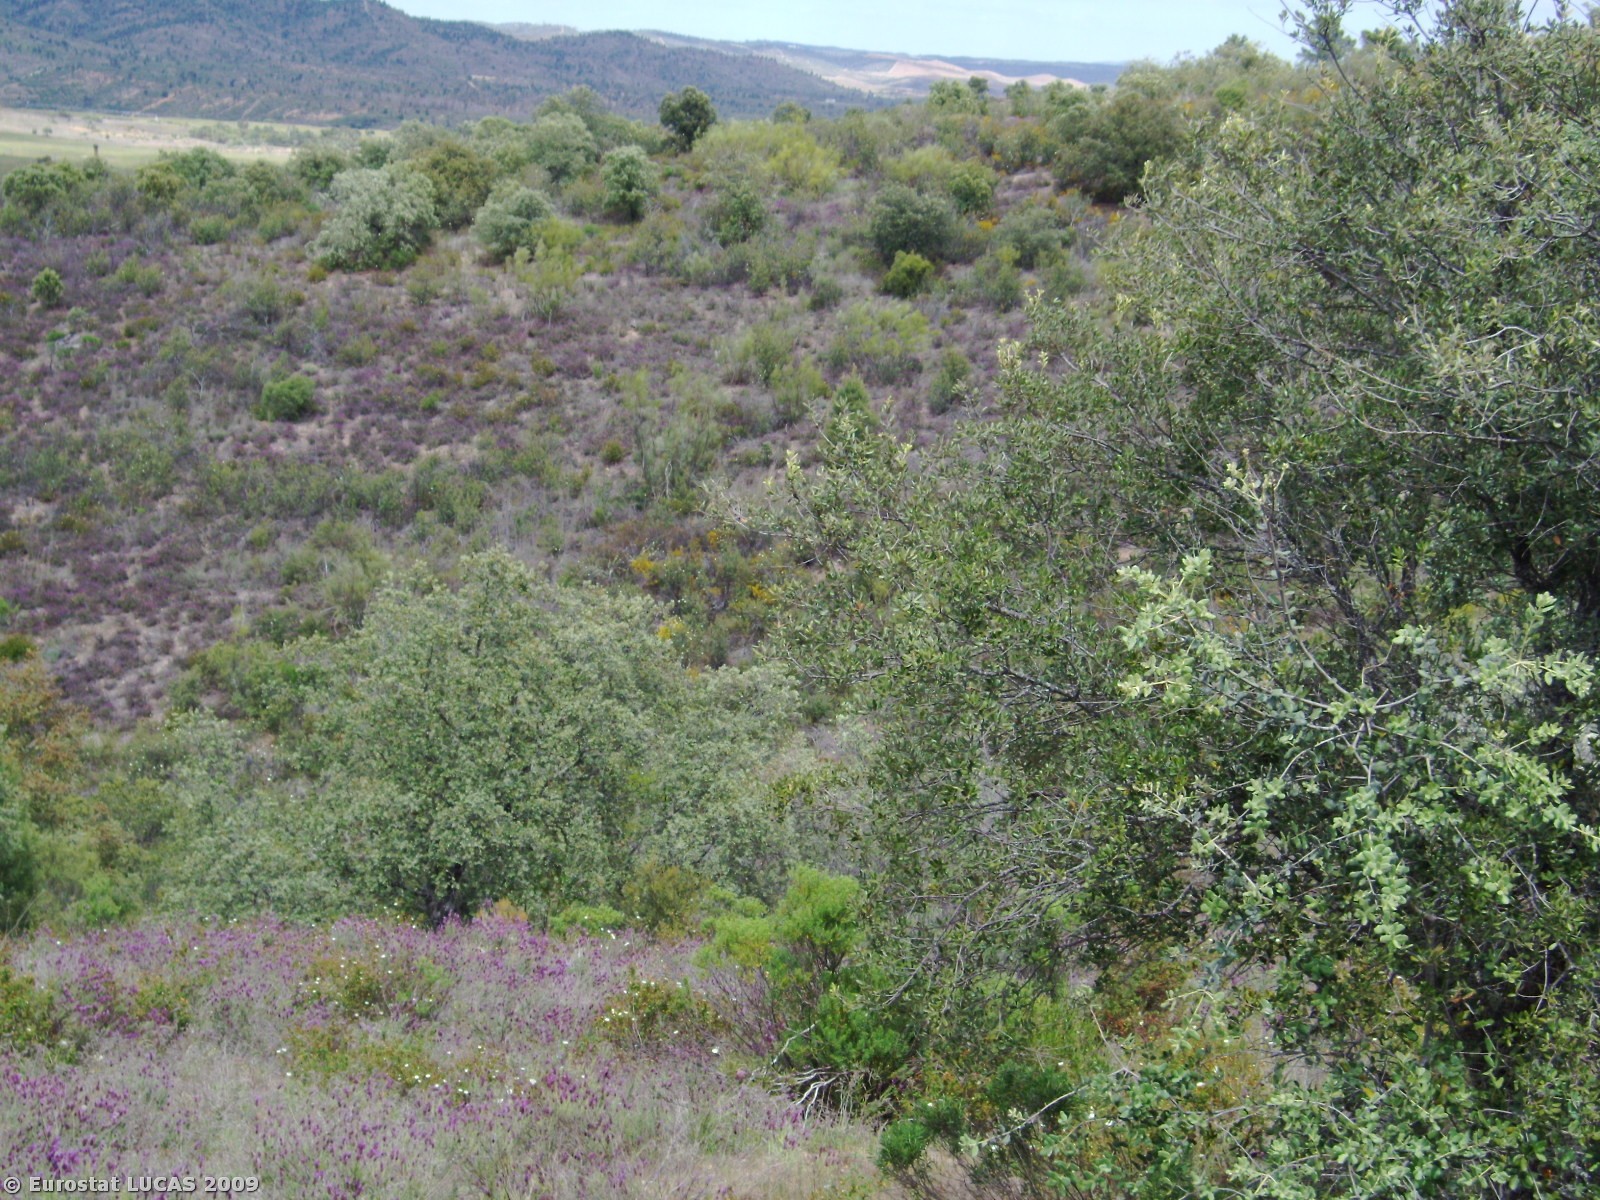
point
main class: Shrubland
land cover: Shrubland with sparse tree cover
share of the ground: > 75 %
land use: Nature reserves
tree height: > 5 m
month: April
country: PT
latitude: 39.7597
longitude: -7.4539
